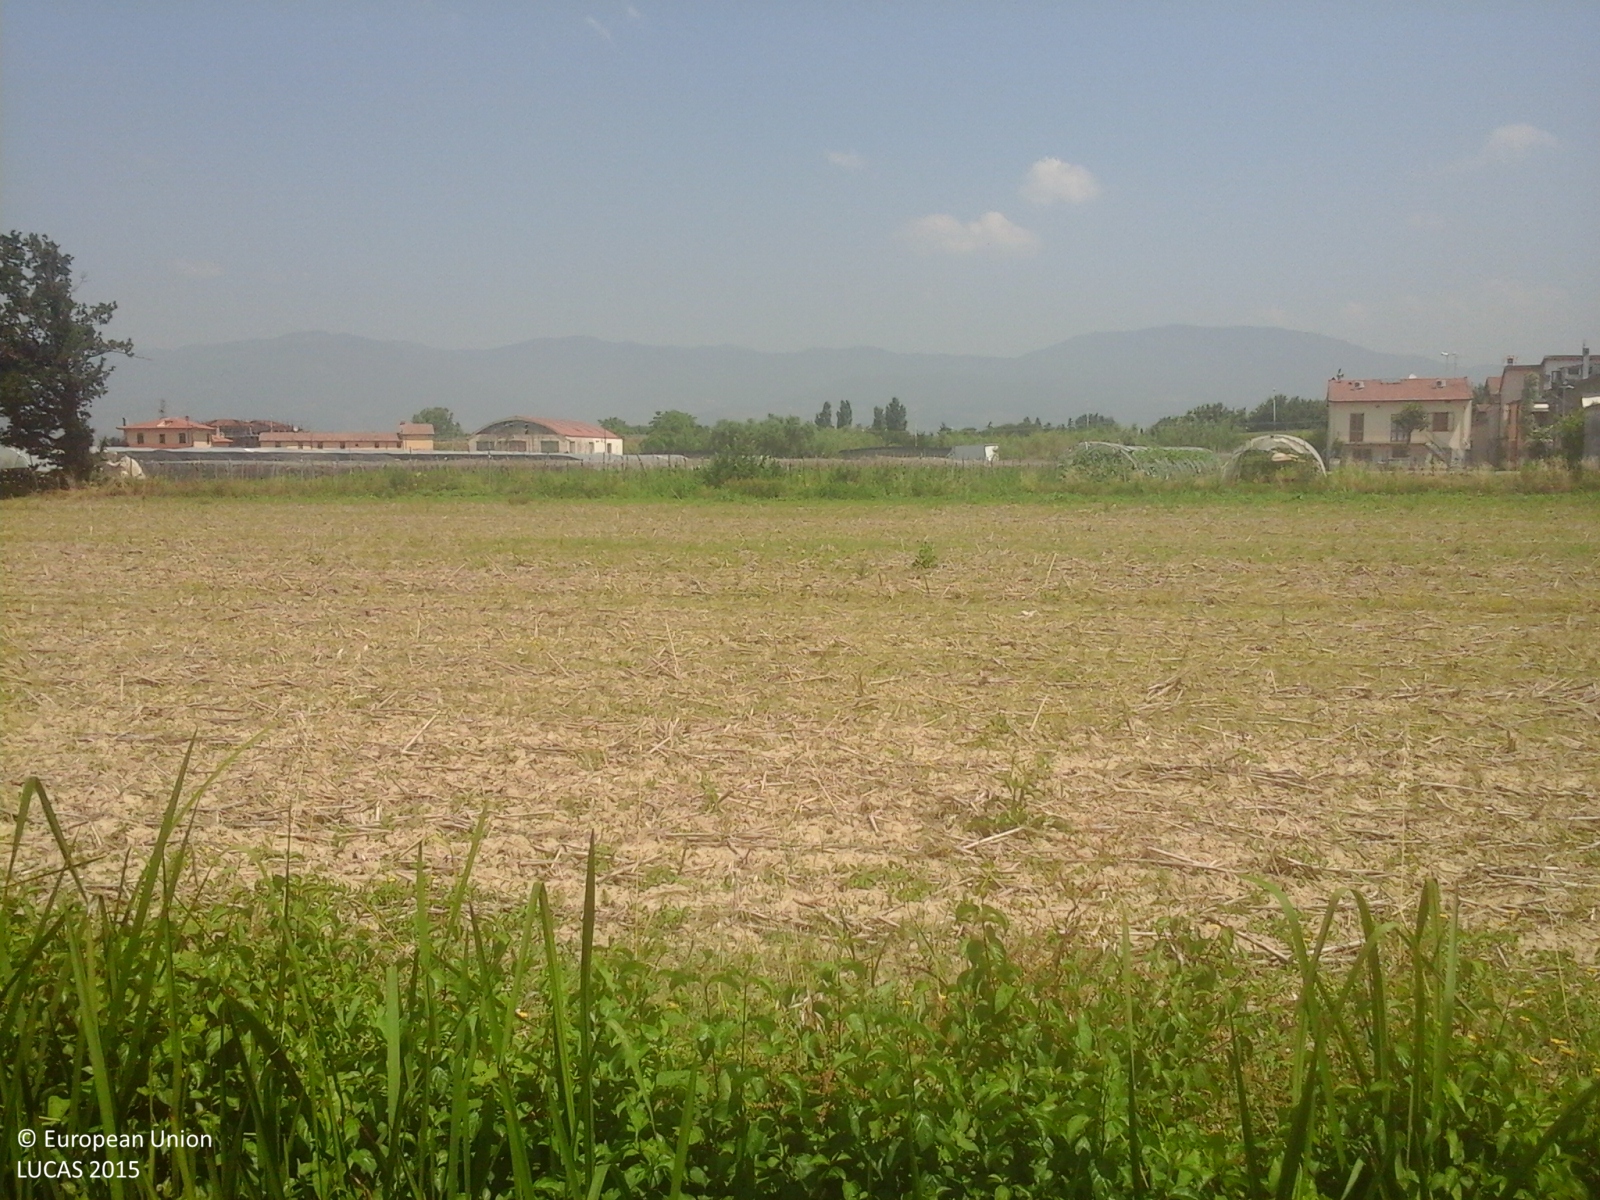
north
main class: Cropland
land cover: Clovers
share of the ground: > 75 %
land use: Agriculture (excluding fallow land and kitchen gardens)
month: June
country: IT
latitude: 43.8764
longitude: 11.0303
